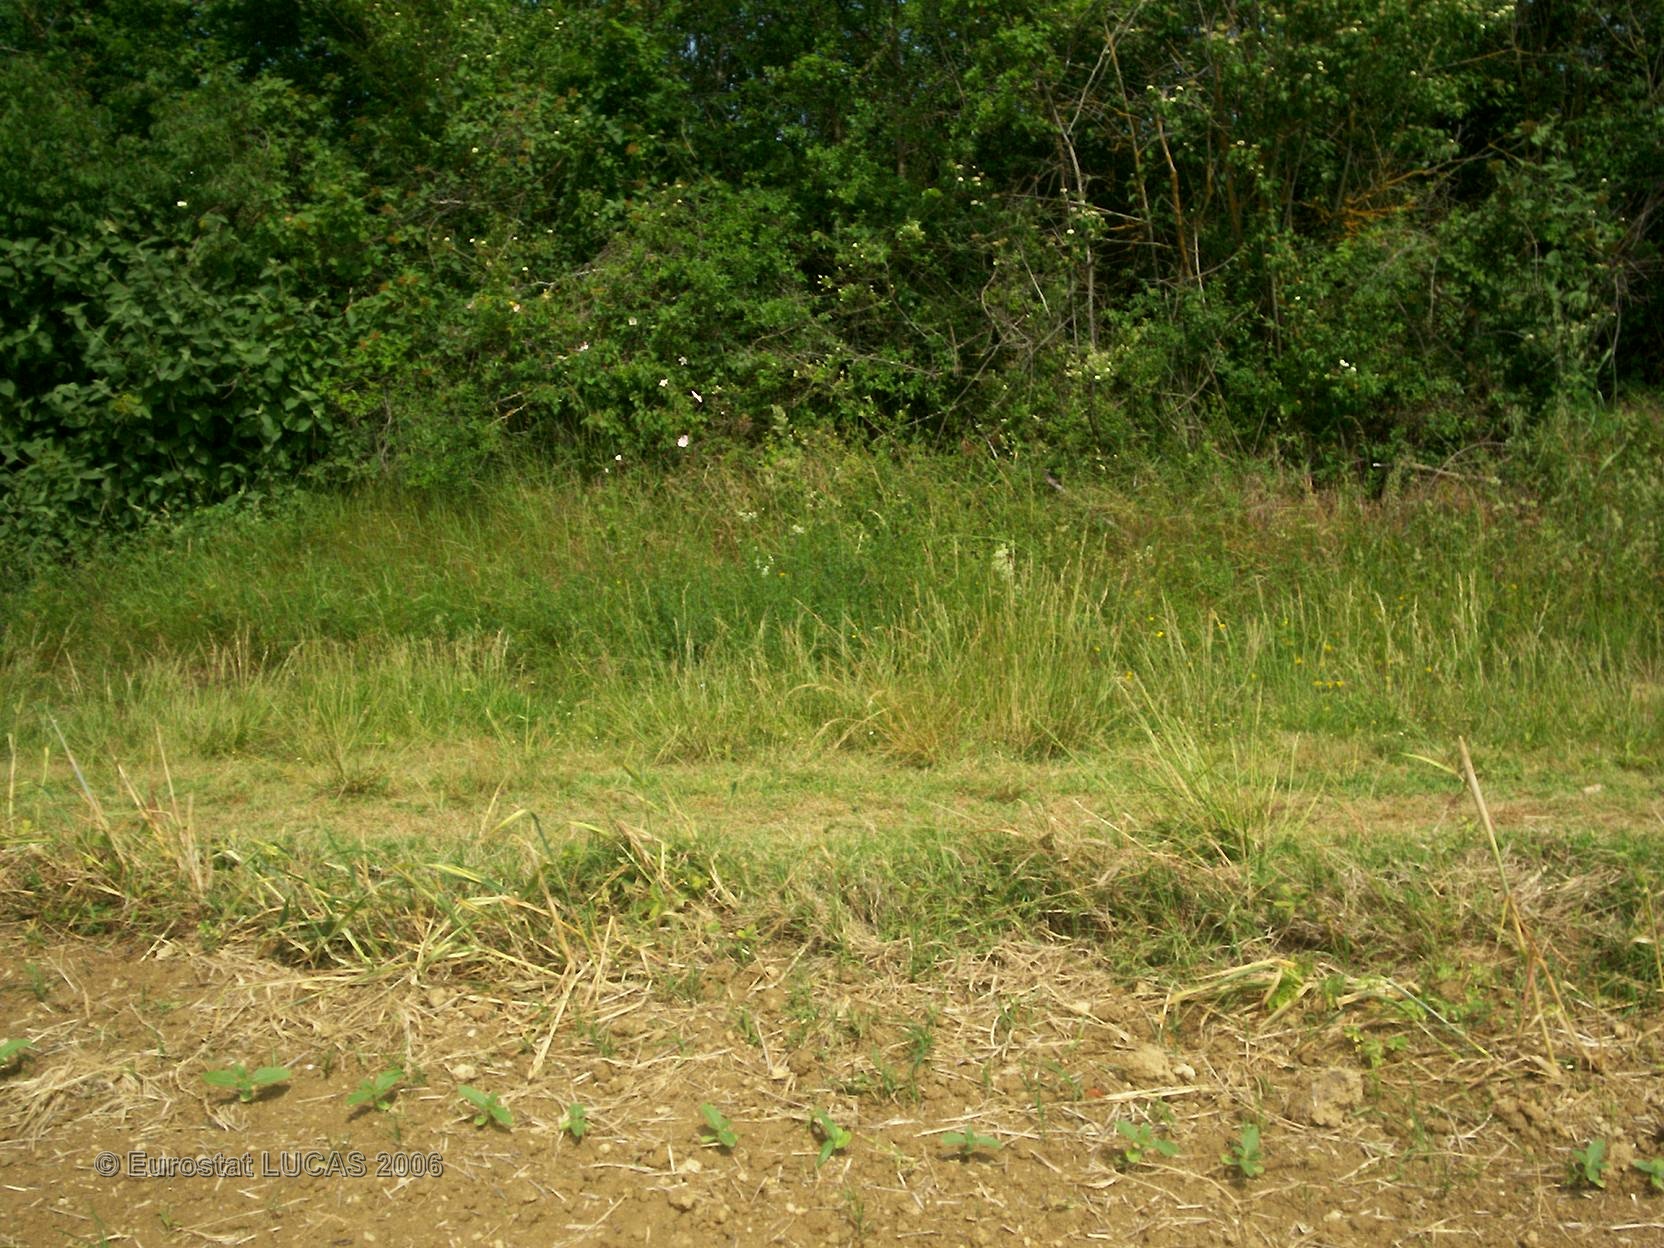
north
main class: Cropland
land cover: Soya
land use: Agriculture (excluding fallow land and kitchen gardens)
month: May
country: FR
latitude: 43.4751
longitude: 0.8646
